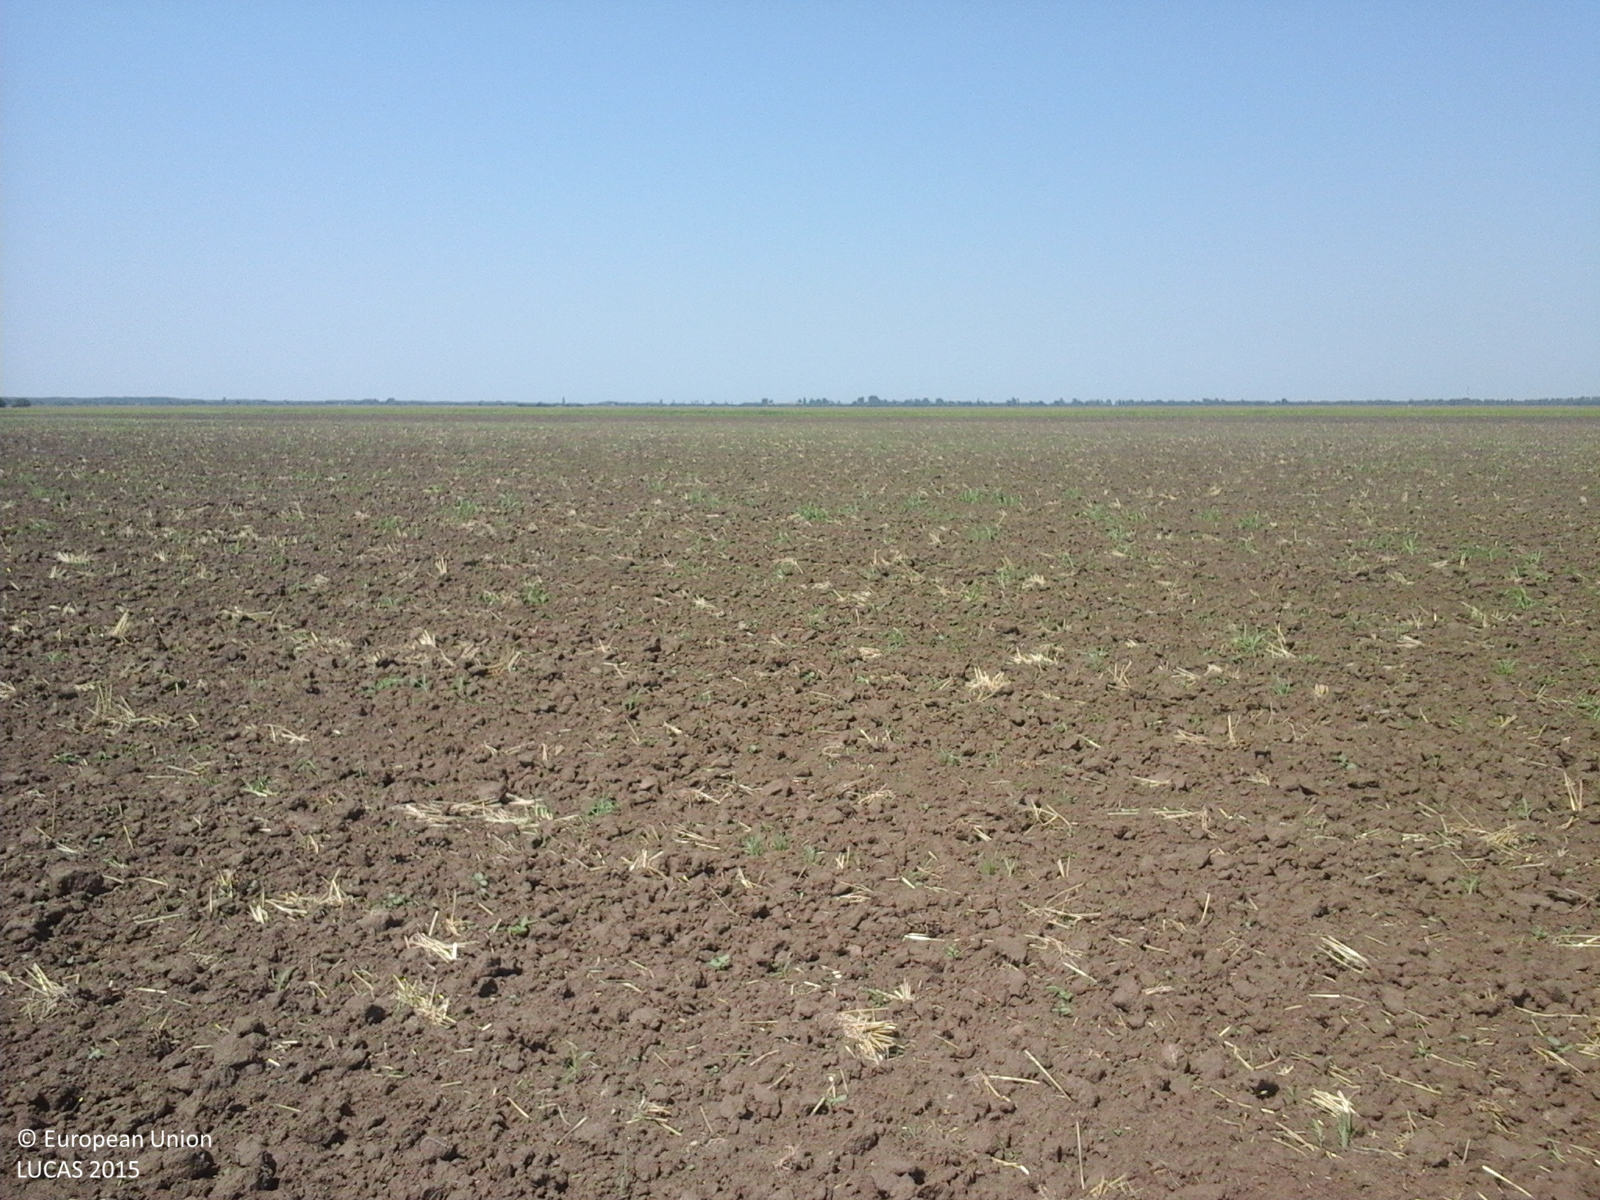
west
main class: Cropland
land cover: Common wheat
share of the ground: < 10 %
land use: Agriculture (excluding fallow land and kitchen gardens)
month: July
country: RO
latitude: 44.6848
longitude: 26.7662
